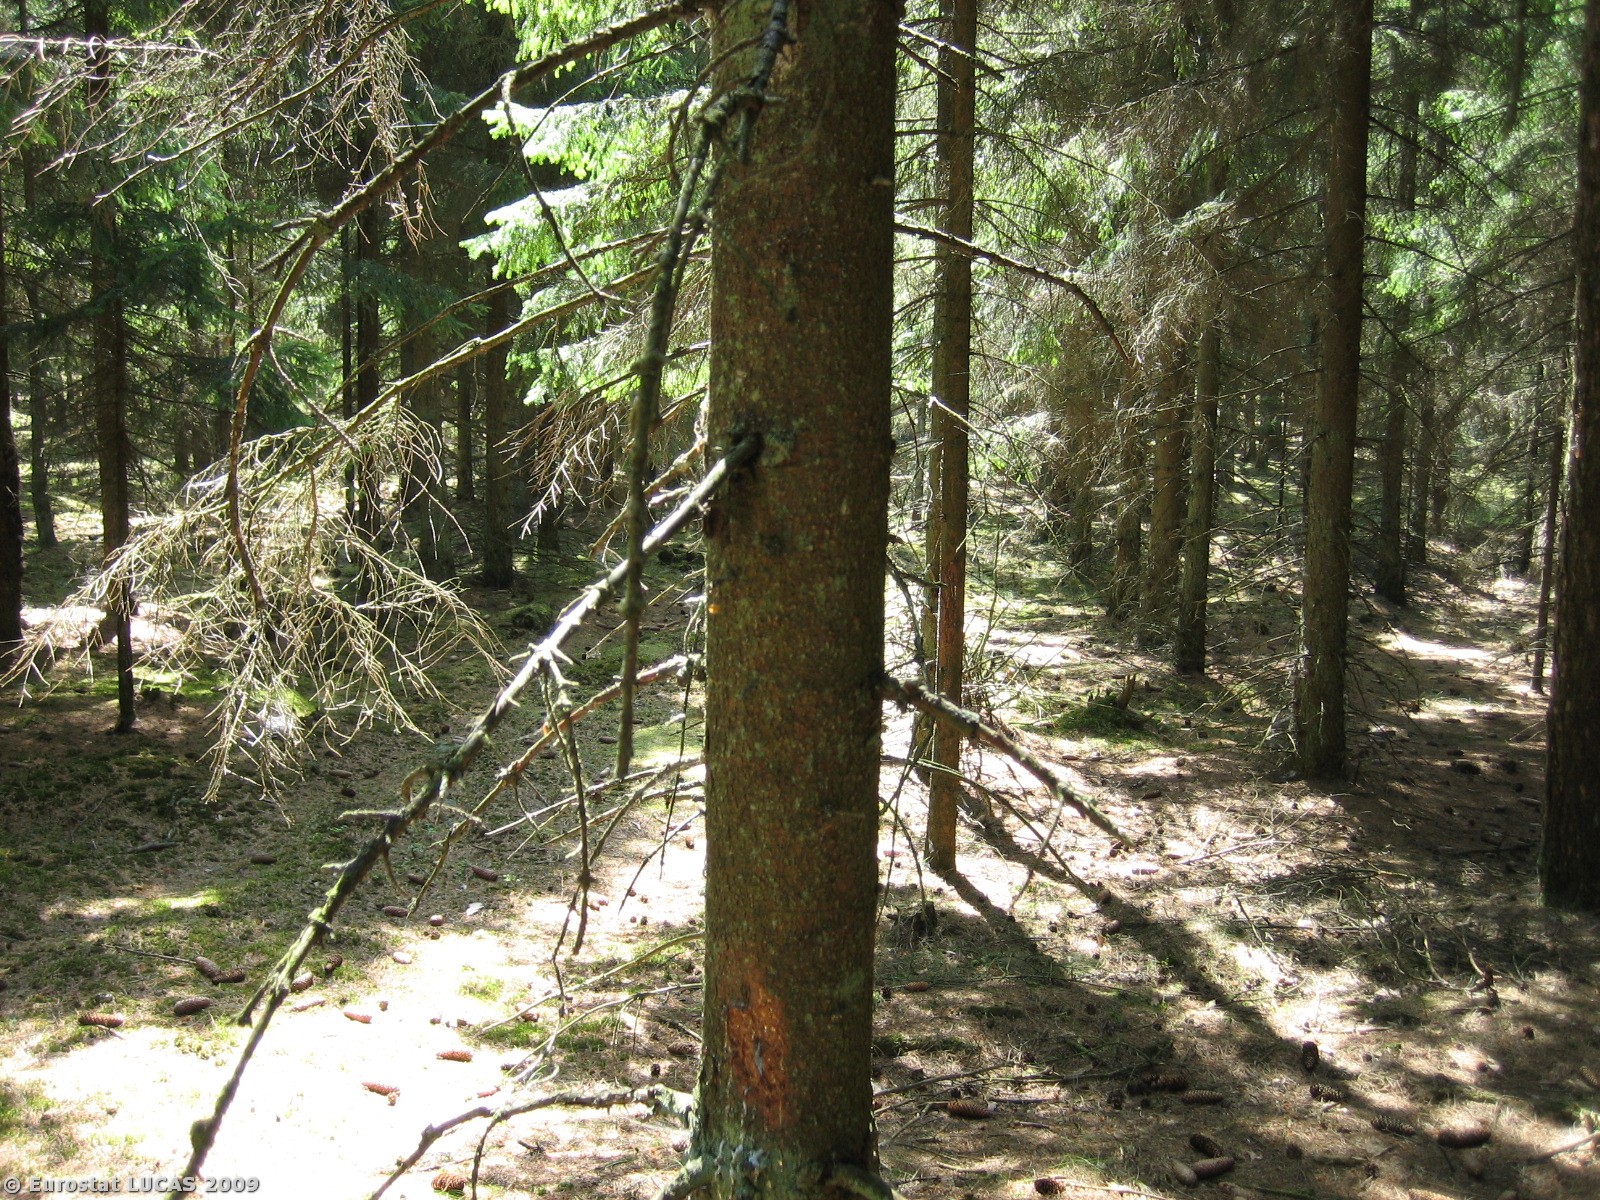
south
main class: Woodland
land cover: Coniferous woodland
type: hemiboreal forest and nemoral coniferous forest and mixed broadleaved-coniferous forest
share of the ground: > 75 %
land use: Forestry
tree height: > 5 m
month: July
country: DK
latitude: 55.6266
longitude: 9.0004
